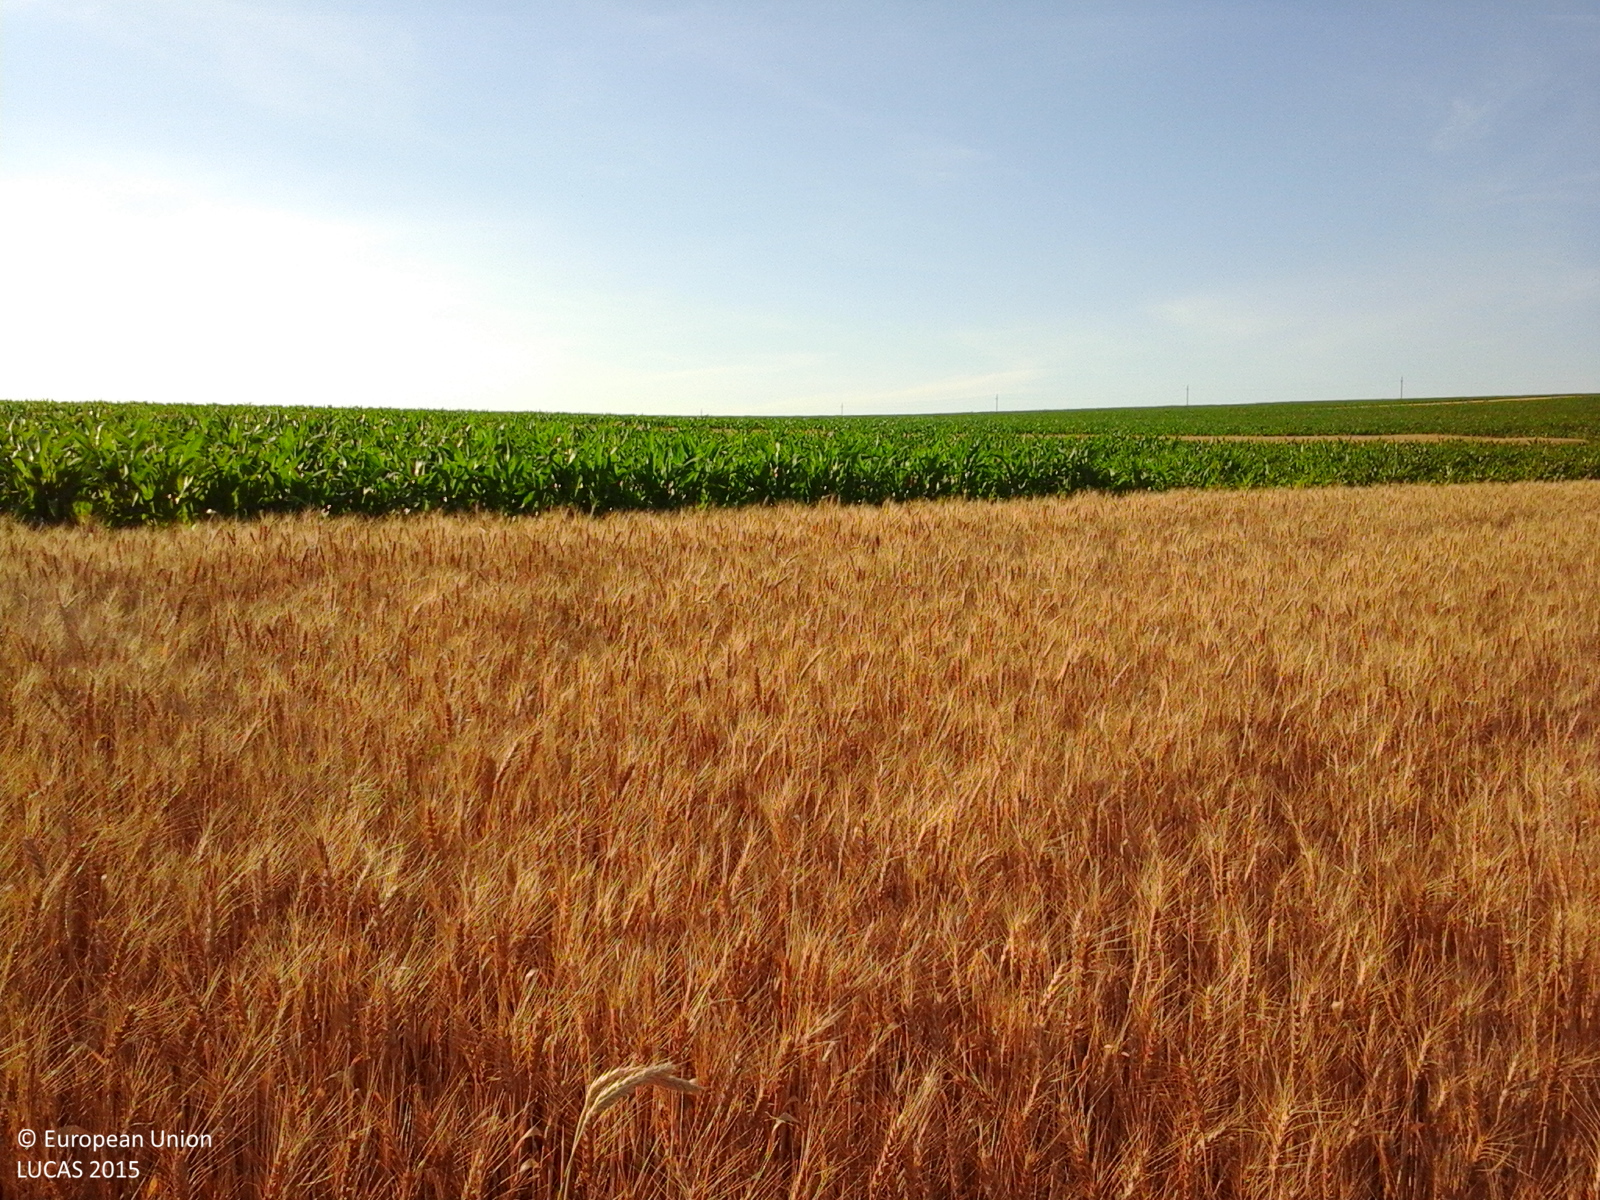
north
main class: Cropland
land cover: Common wheat
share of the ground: > 75 %
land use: Agriculture (excluding fallow land and kitchen gardens)
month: June
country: RO
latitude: 47.4104
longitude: 27.0817
